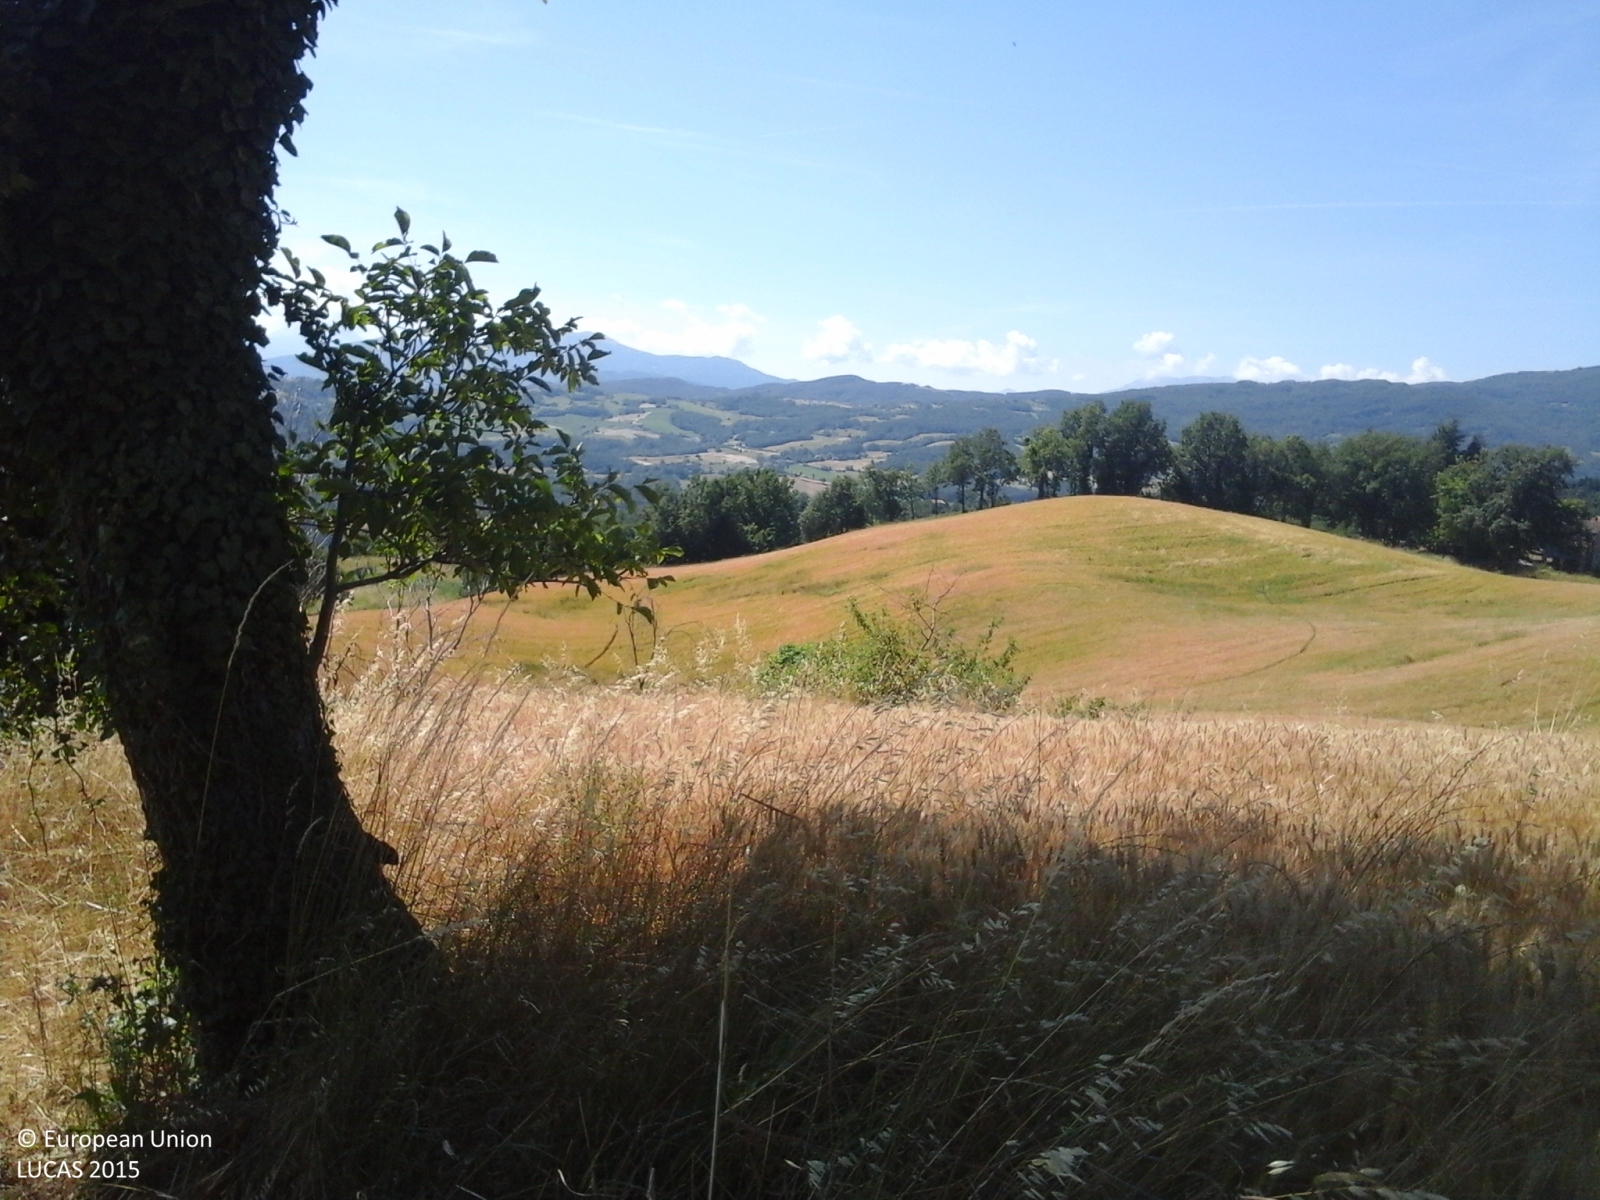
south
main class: Cropland
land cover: Common wheat
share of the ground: > 75 %
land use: Agriculture (excluding fallow land and kitchen gardens)
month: June
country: IT
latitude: 44.5307
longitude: 10.2134
